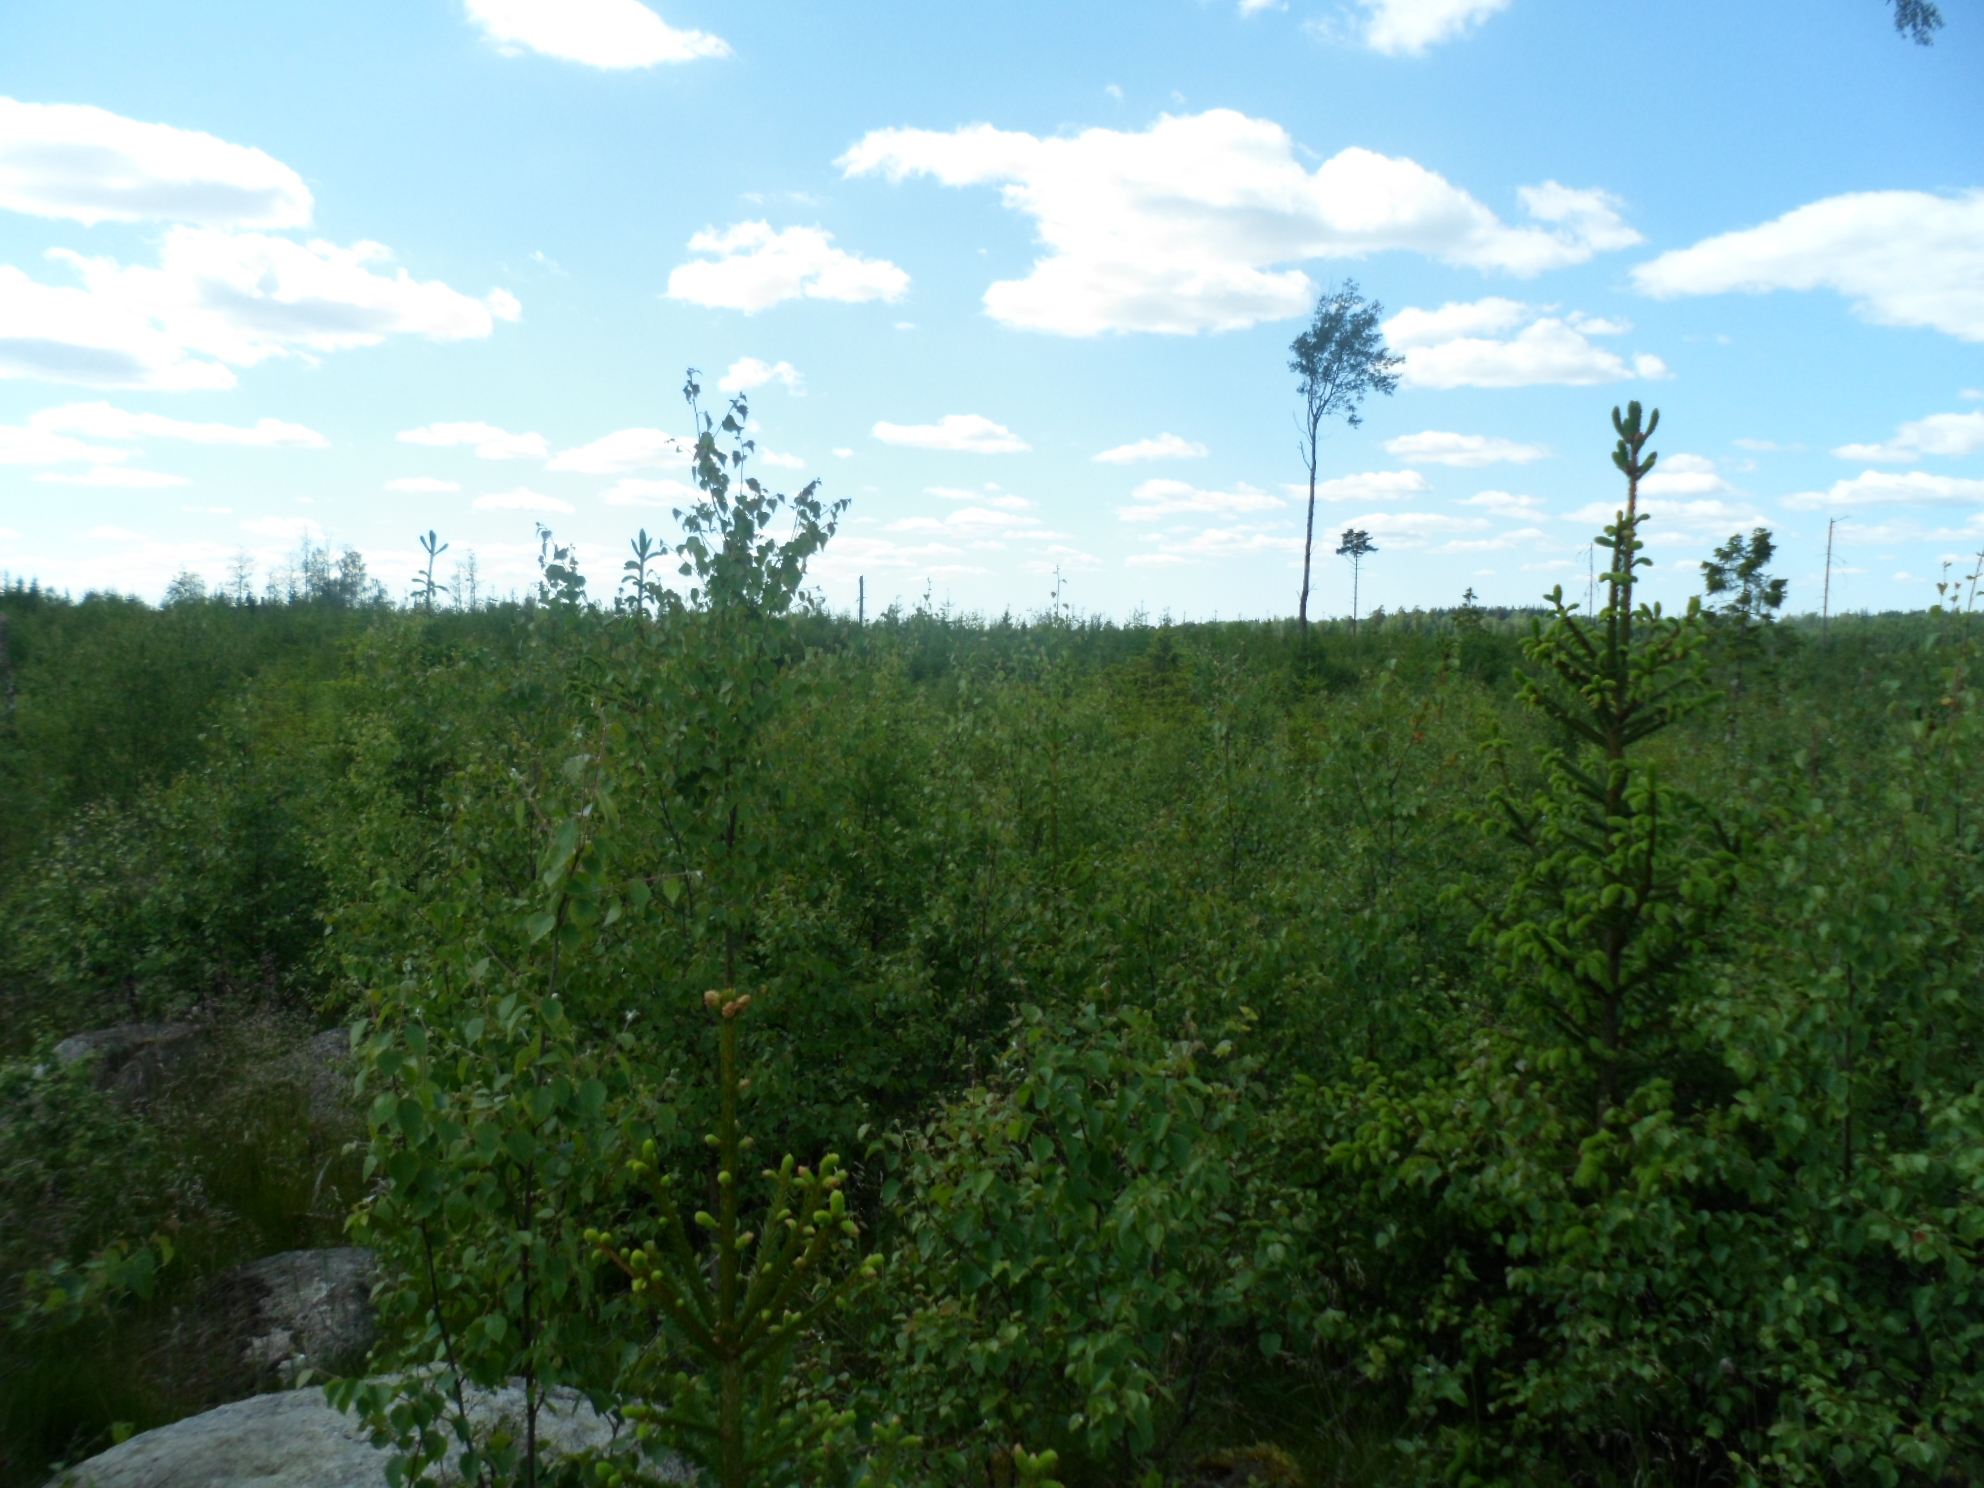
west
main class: Woodland
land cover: Spruce dominated mixed woodland
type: boreal forest
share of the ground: > 75 %
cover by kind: broadleaved forest trees 45 %, coniferous forest trees 35 %, herbaceous plants 15 %, shrubs 5 %
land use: Forestry
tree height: < 5 m
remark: Clear cut
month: July
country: SE
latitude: 57.4267
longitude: 14.4090
